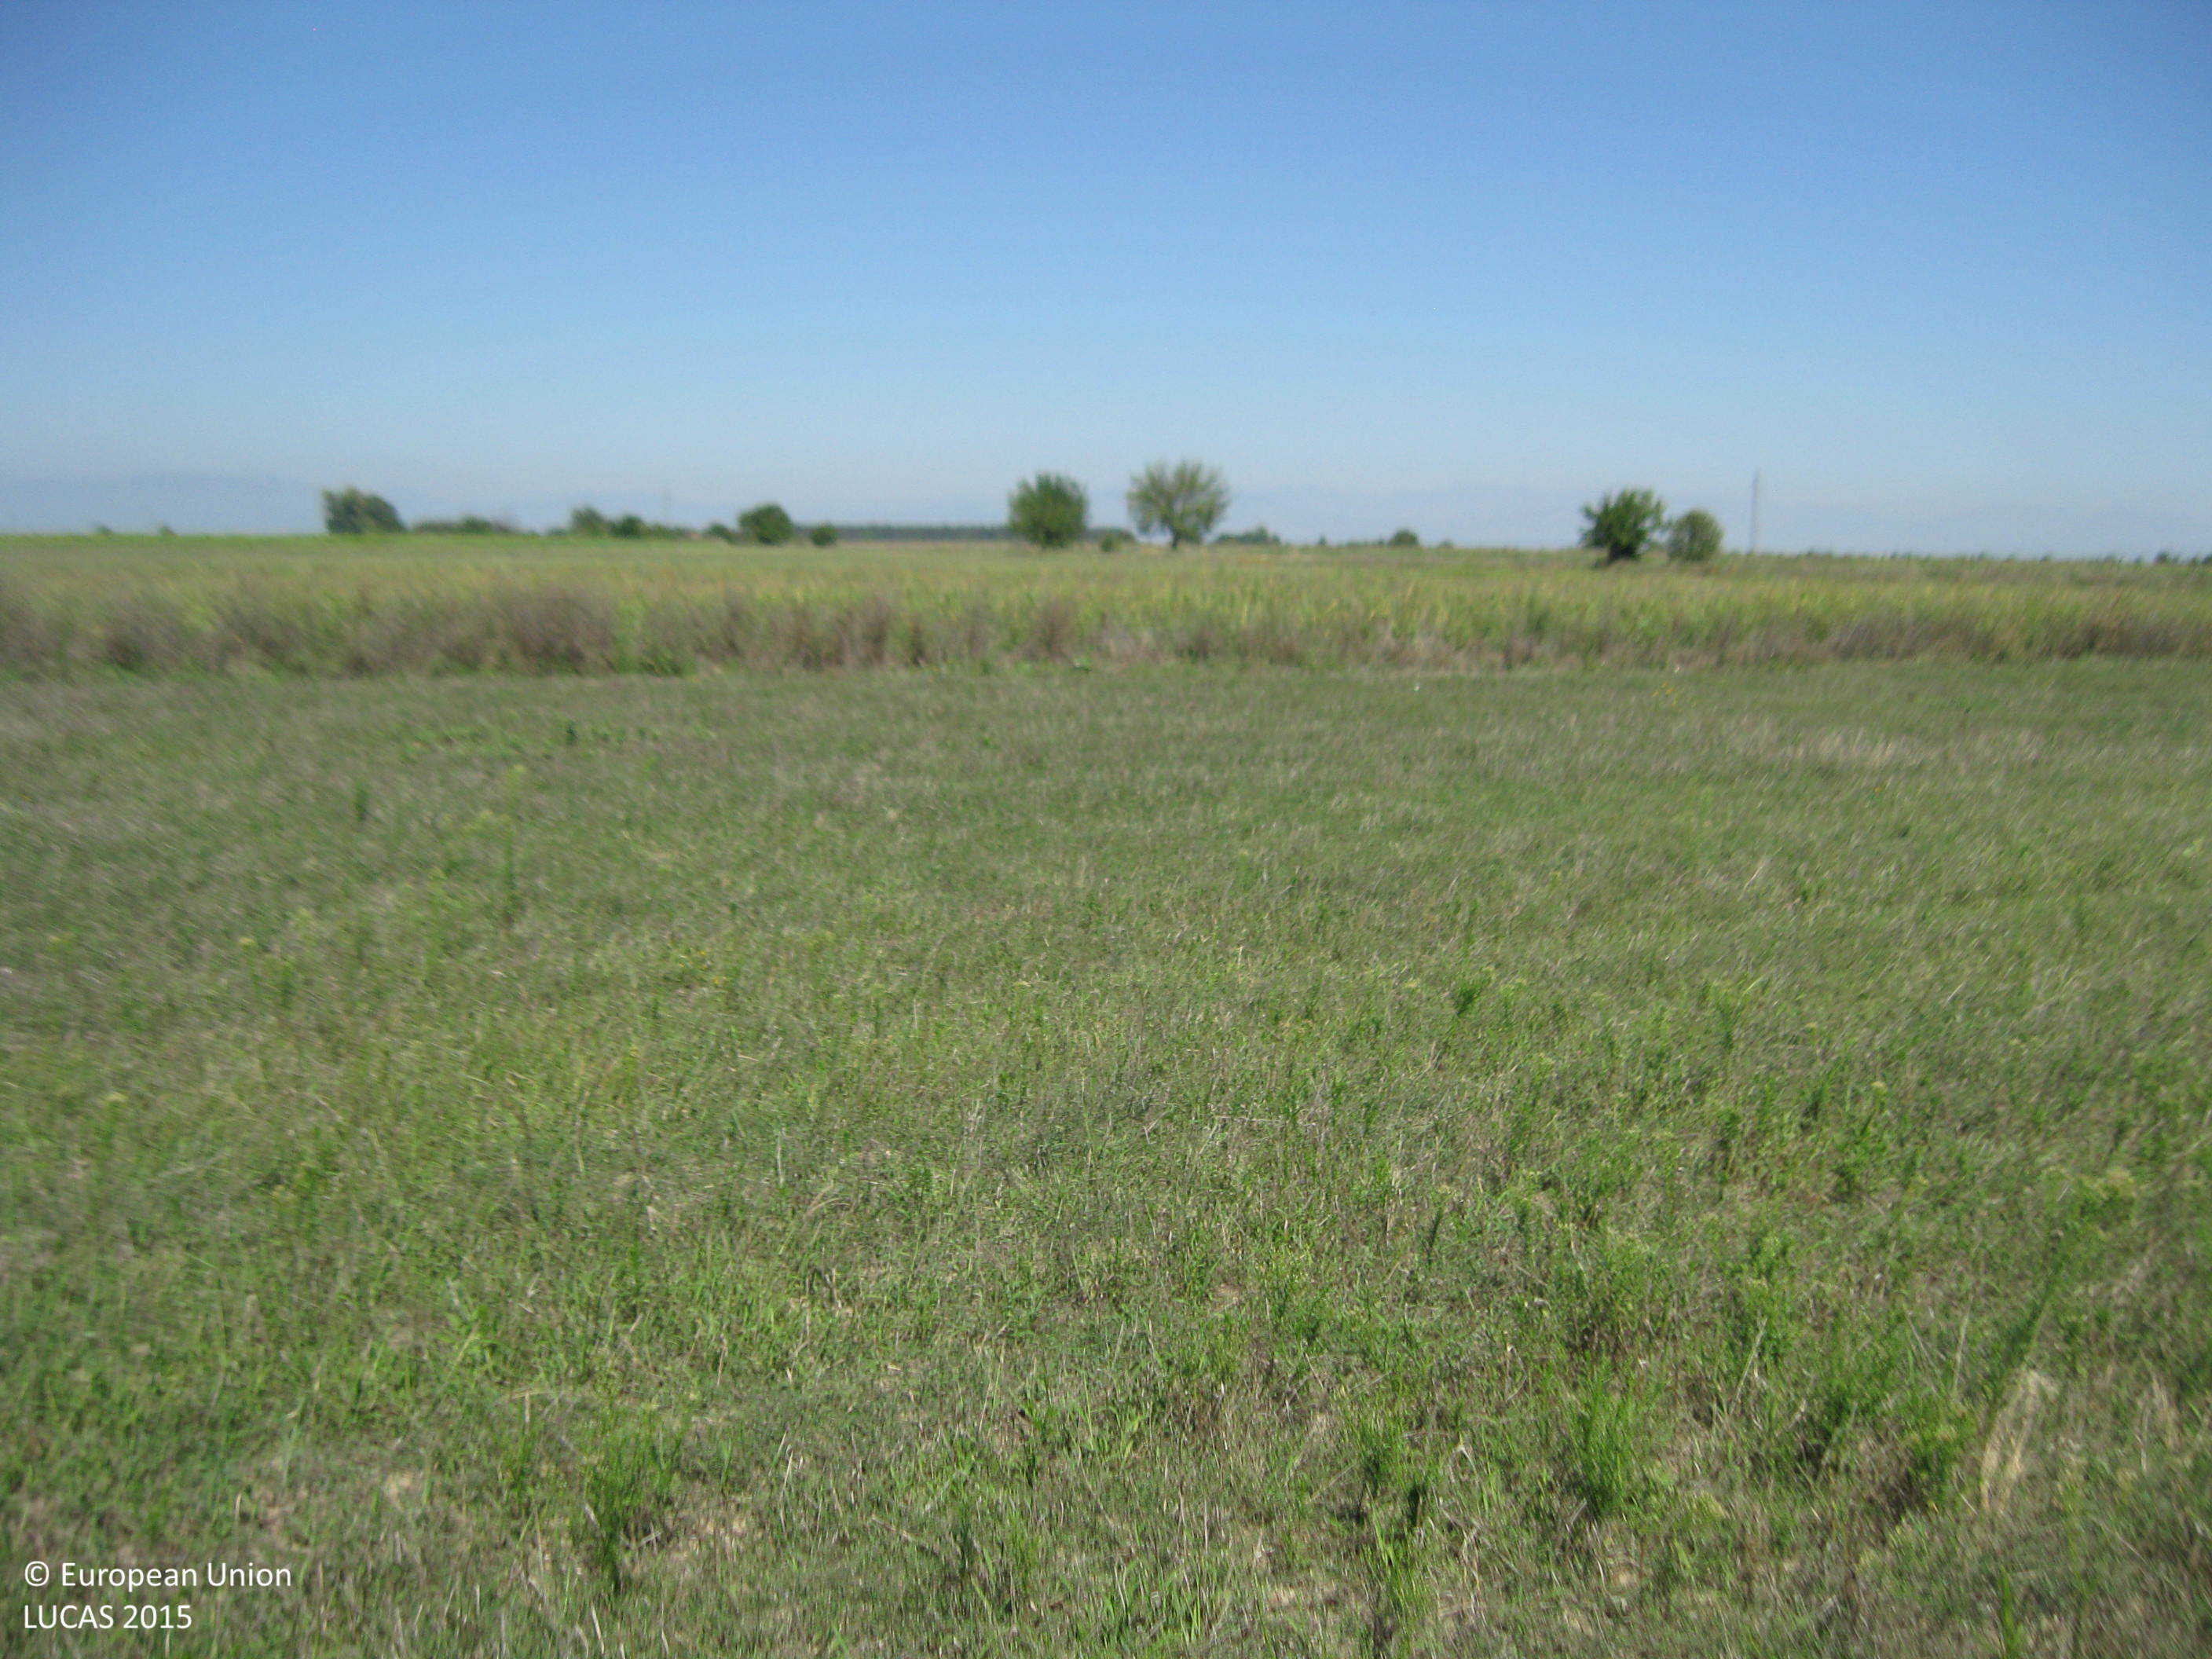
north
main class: Cropland
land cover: Common wheat
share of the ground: < 10 %
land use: Agriculture (excluding fallow land and kitchen gardens)
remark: Harvested field
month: September
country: BG
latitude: 42.2236
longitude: 24.6495
